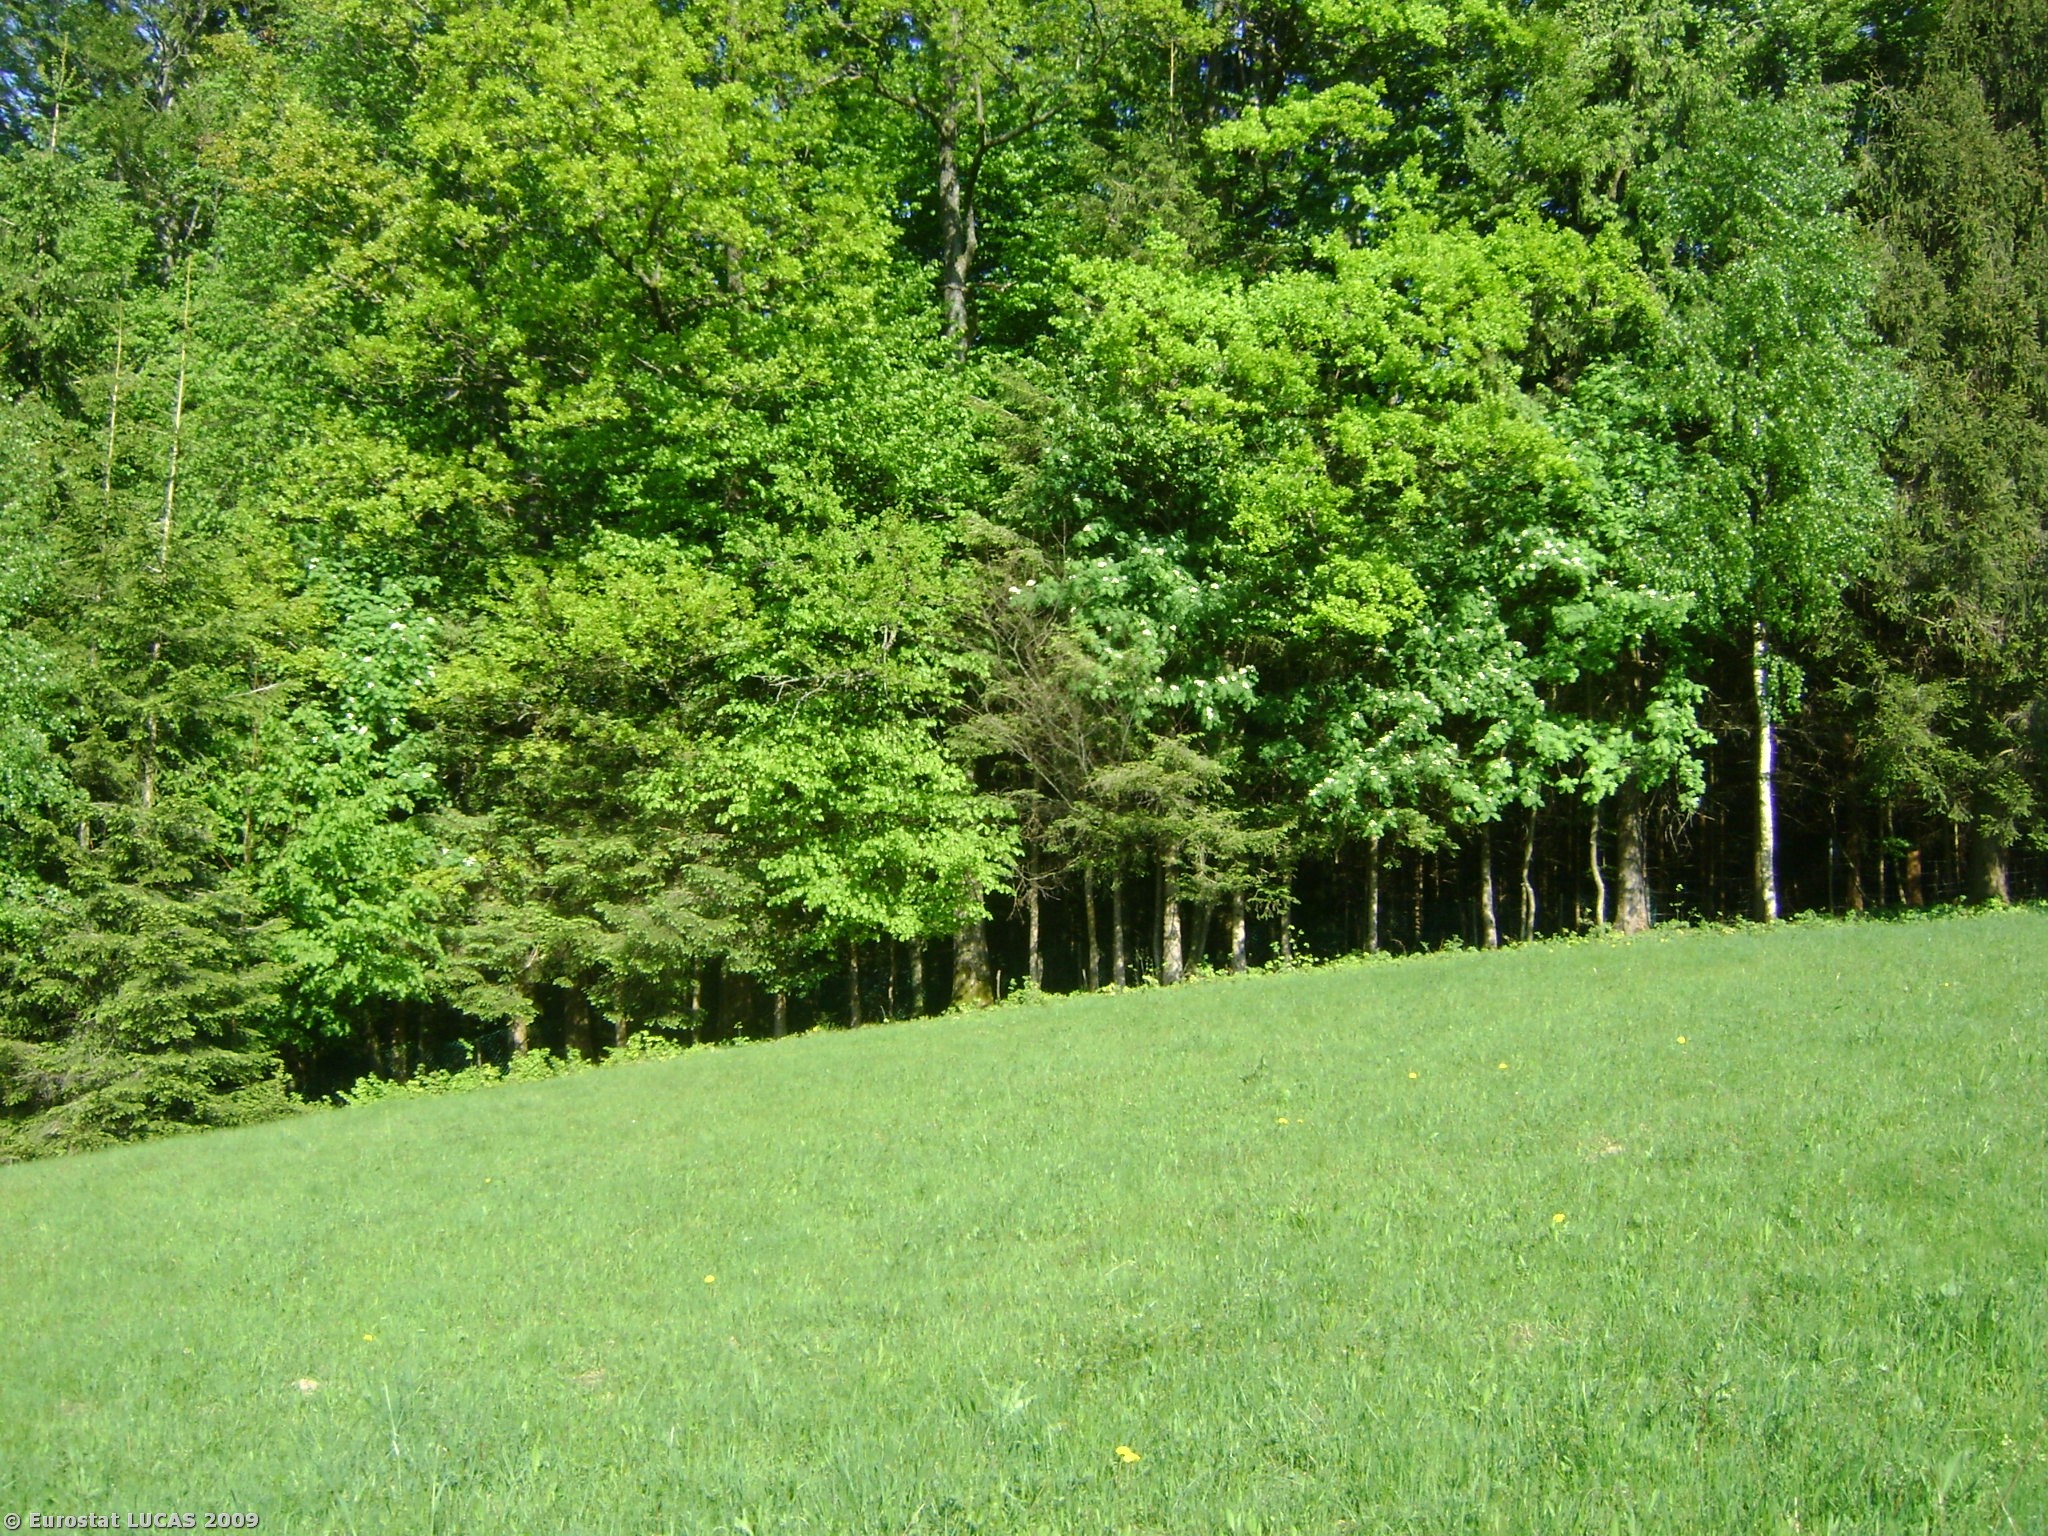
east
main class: Grassland
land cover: Grassland without tree/shrub cover
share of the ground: > 75 %
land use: Agriculture (excluding fallow land and kitchen gardens)
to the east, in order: Grassland without tree/shrub cover; Fences; Coniferous woodland; Grassland without tree/shrub cover; Mixed woodland; Ditches and canals; Mixed woodland; Artificial constructions in urban areas; Paved roads, cycling and walking lanes; Grass margins; Fences; Grassland without tree/shrub cover; Coniferous woodland
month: May
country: AT
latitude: 47.8336
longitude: 13.2452
